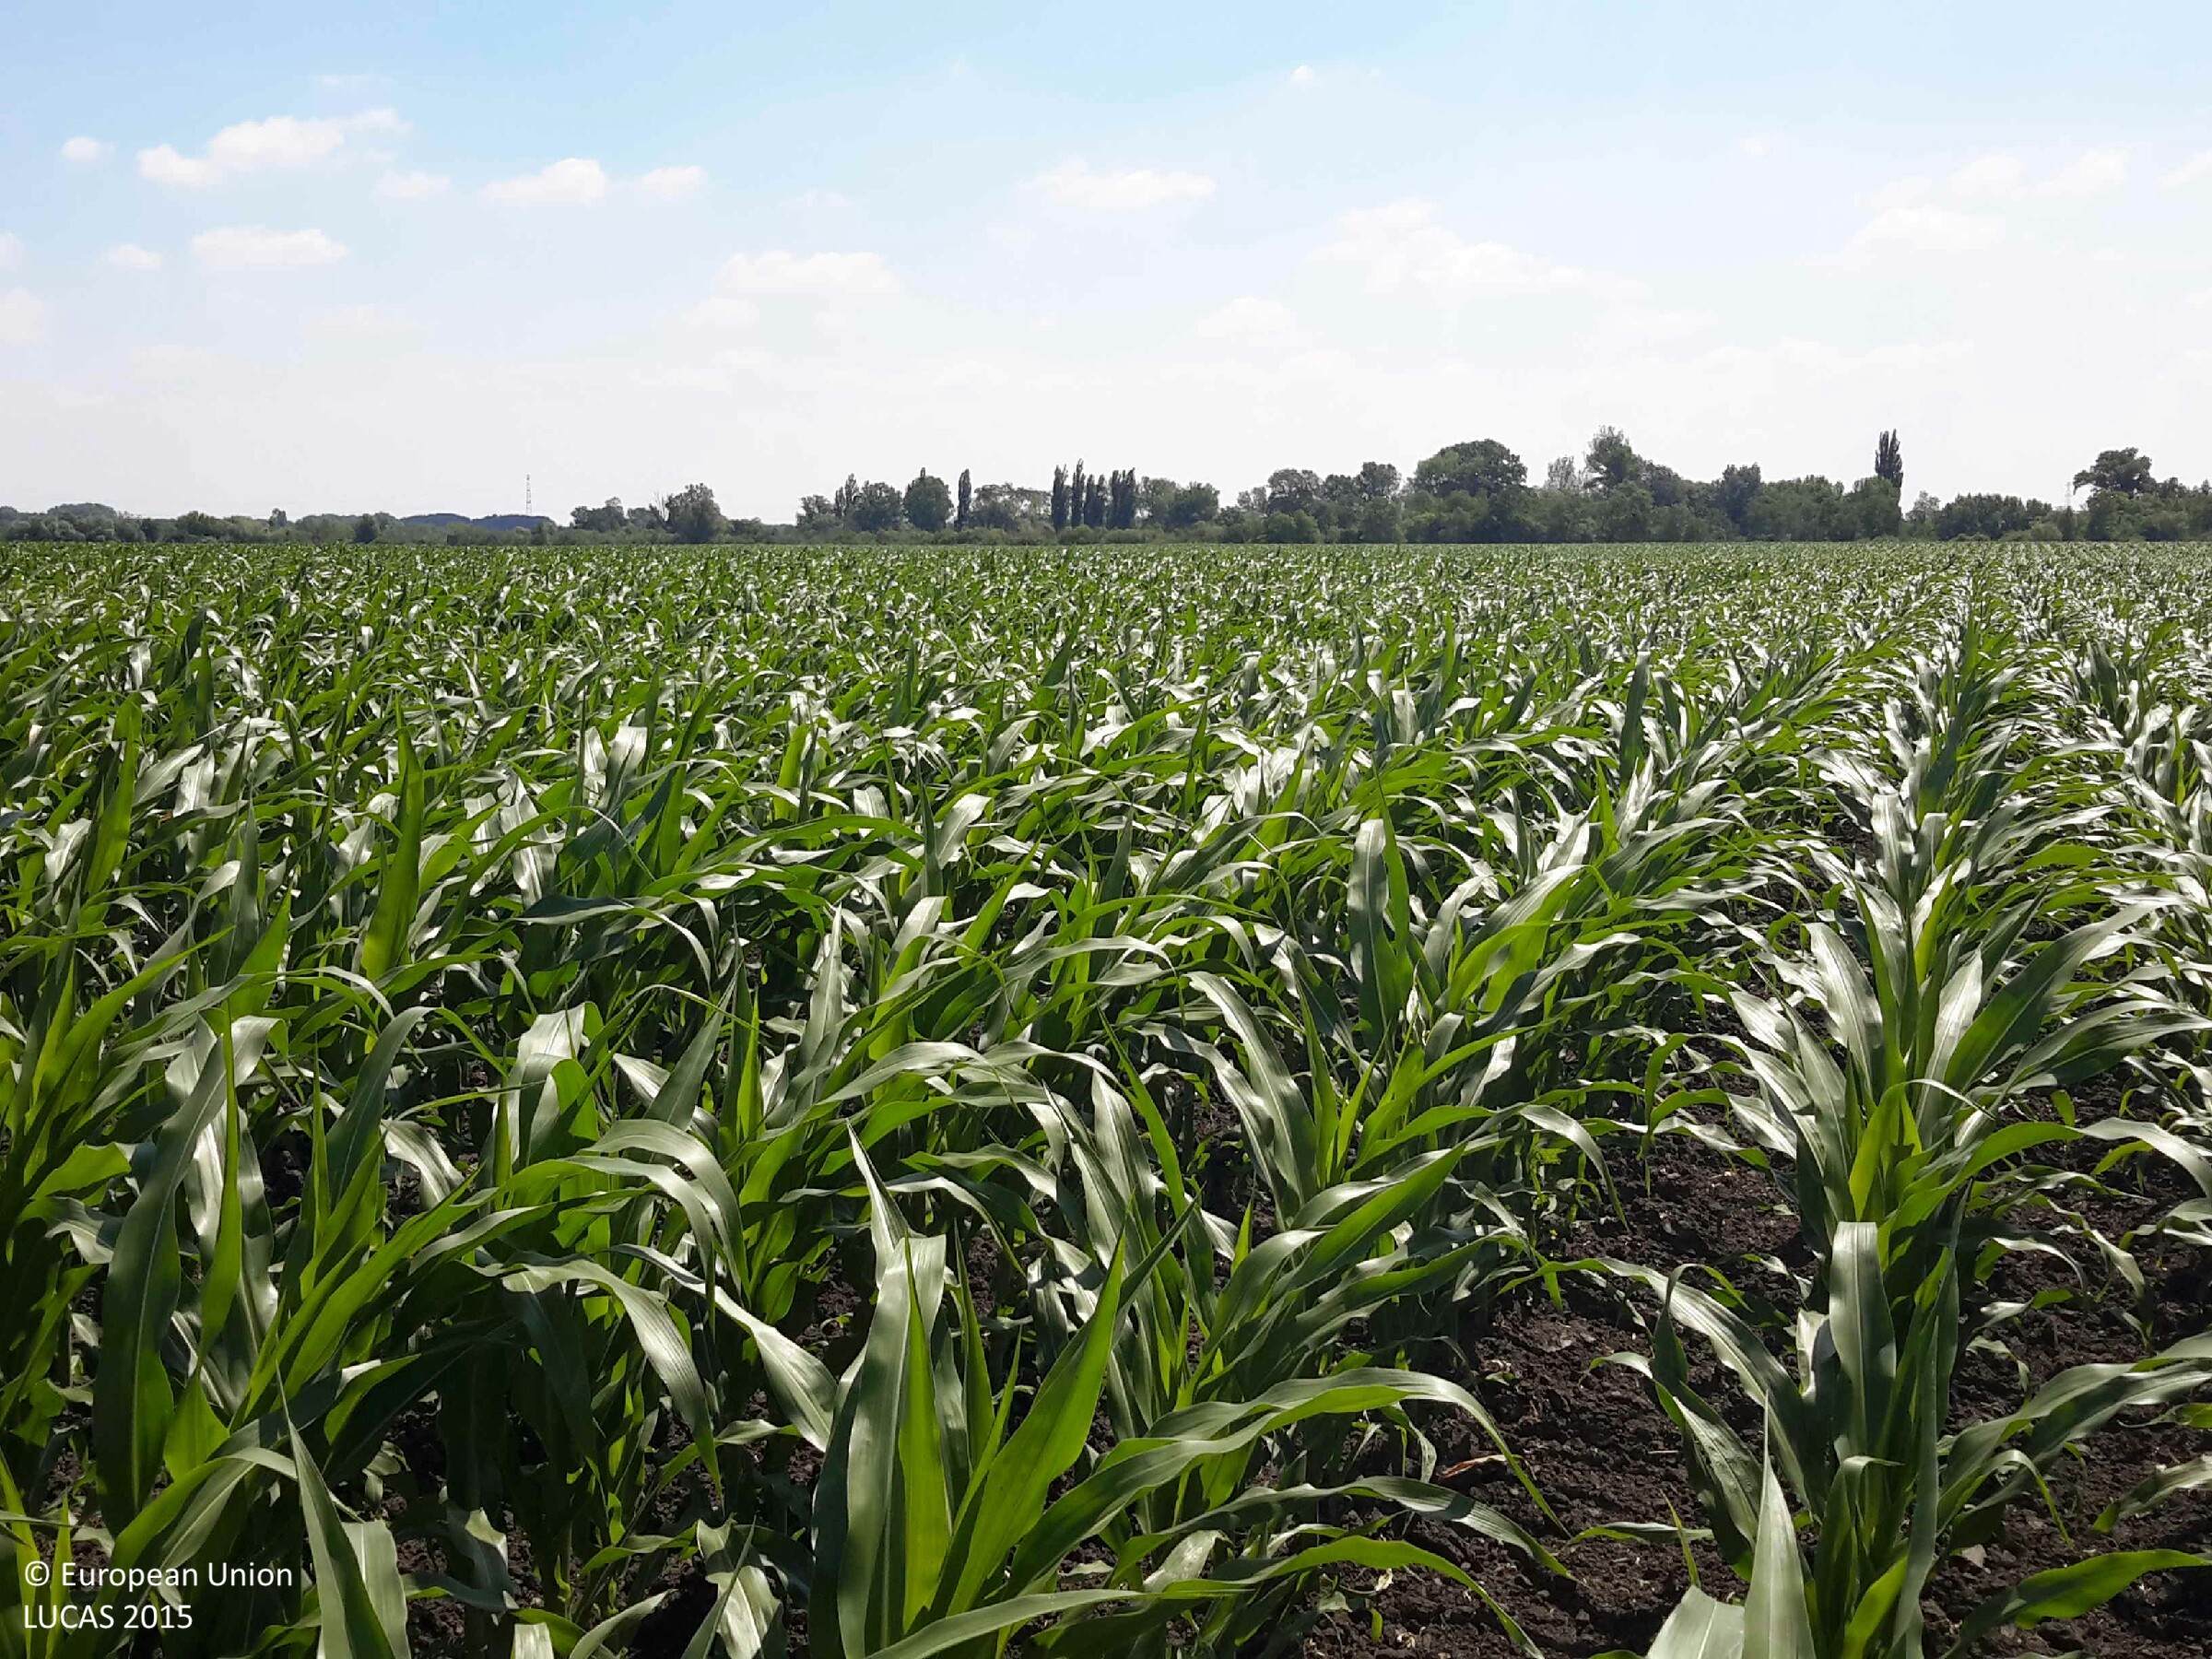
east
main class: Cropland
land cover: Maize
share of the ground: > 75 %
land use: Agriculture (excluding fallow land and kitchen gardens)
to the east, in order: Maize
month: June
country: HU
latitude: 47.6836
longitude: 17.4283
